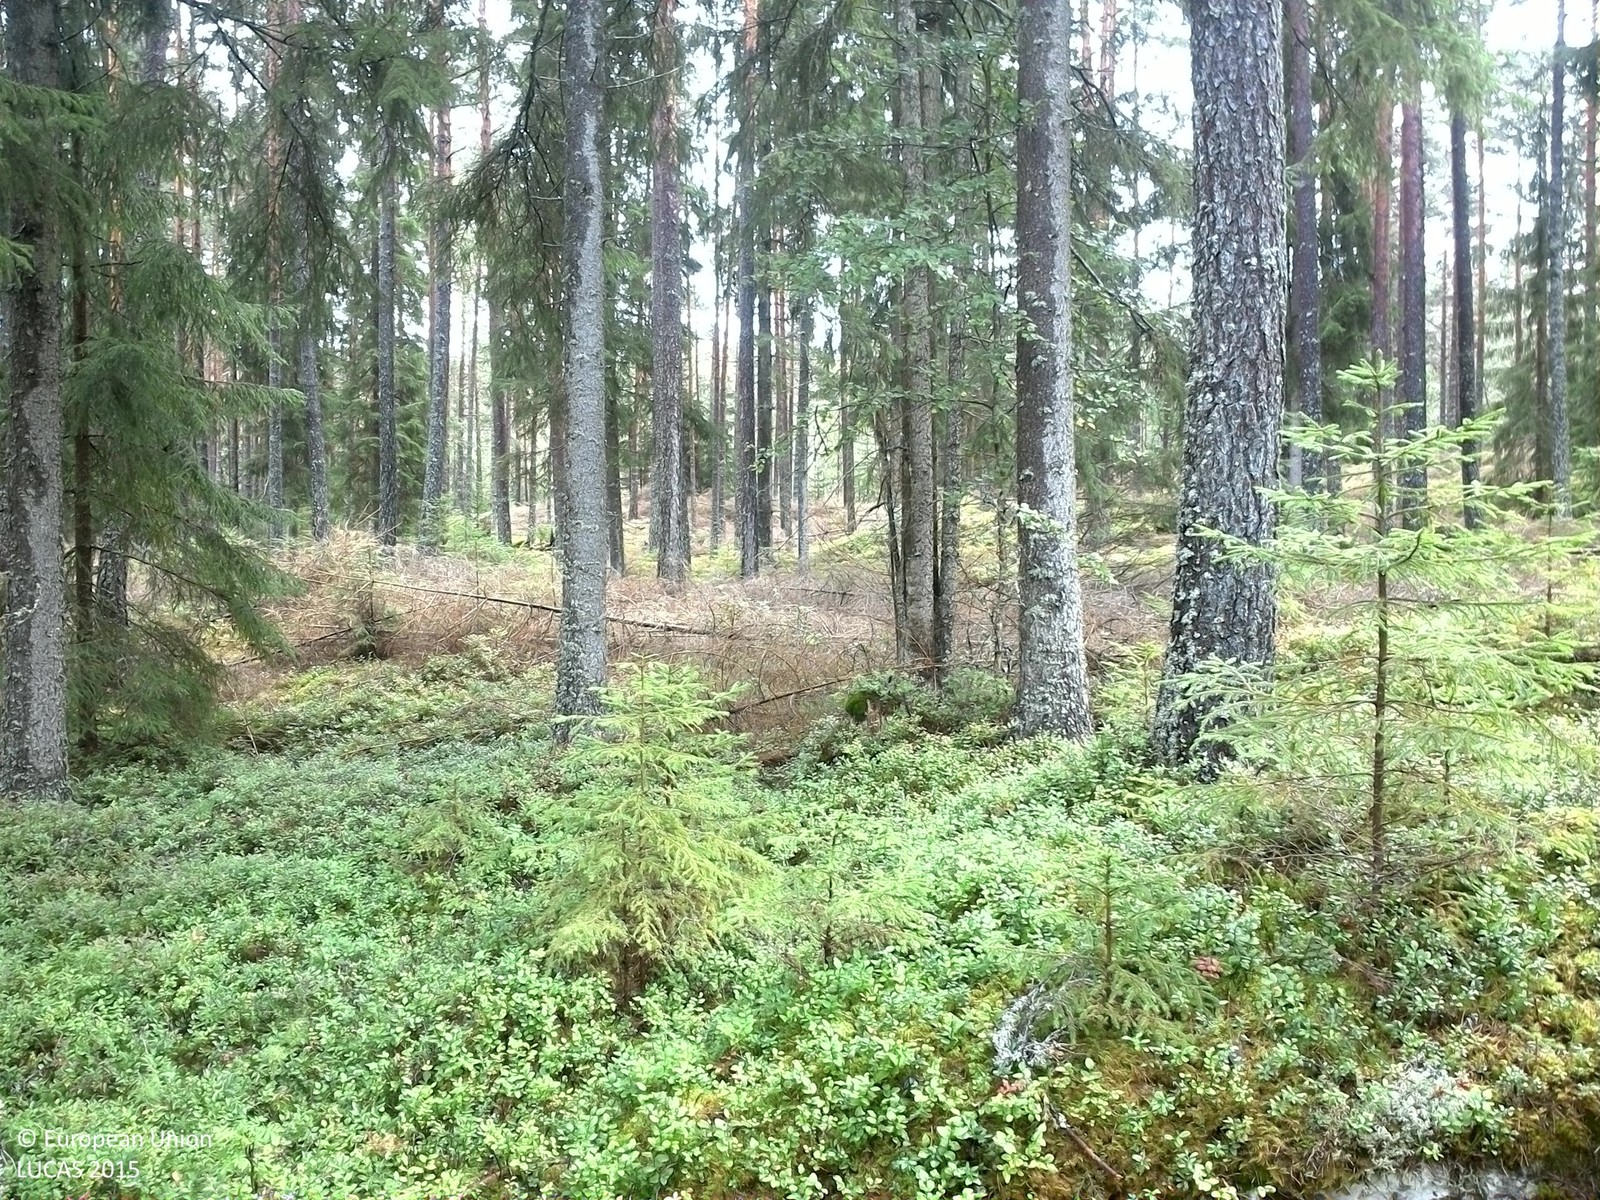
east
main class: Woodland
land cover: Pine dominated coniferous woodland
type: boreal forest
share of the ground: 50 - 75 %
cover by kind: coniferous forest trees 65 %, lichens and mosses 20 %, shrubs 10 %, broadleaved forest trees 5 %
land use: Forestry
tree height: > 5 m
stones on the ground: < 10 %
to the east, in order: Pine dominated coniferous woodland; Pine dominated mixed woodland; Ponds and wetlands; Pine dominated mixed woodland; Pine dominated coniferous woodland
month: September
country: SE
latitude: 59.2656
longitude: 12.0474
